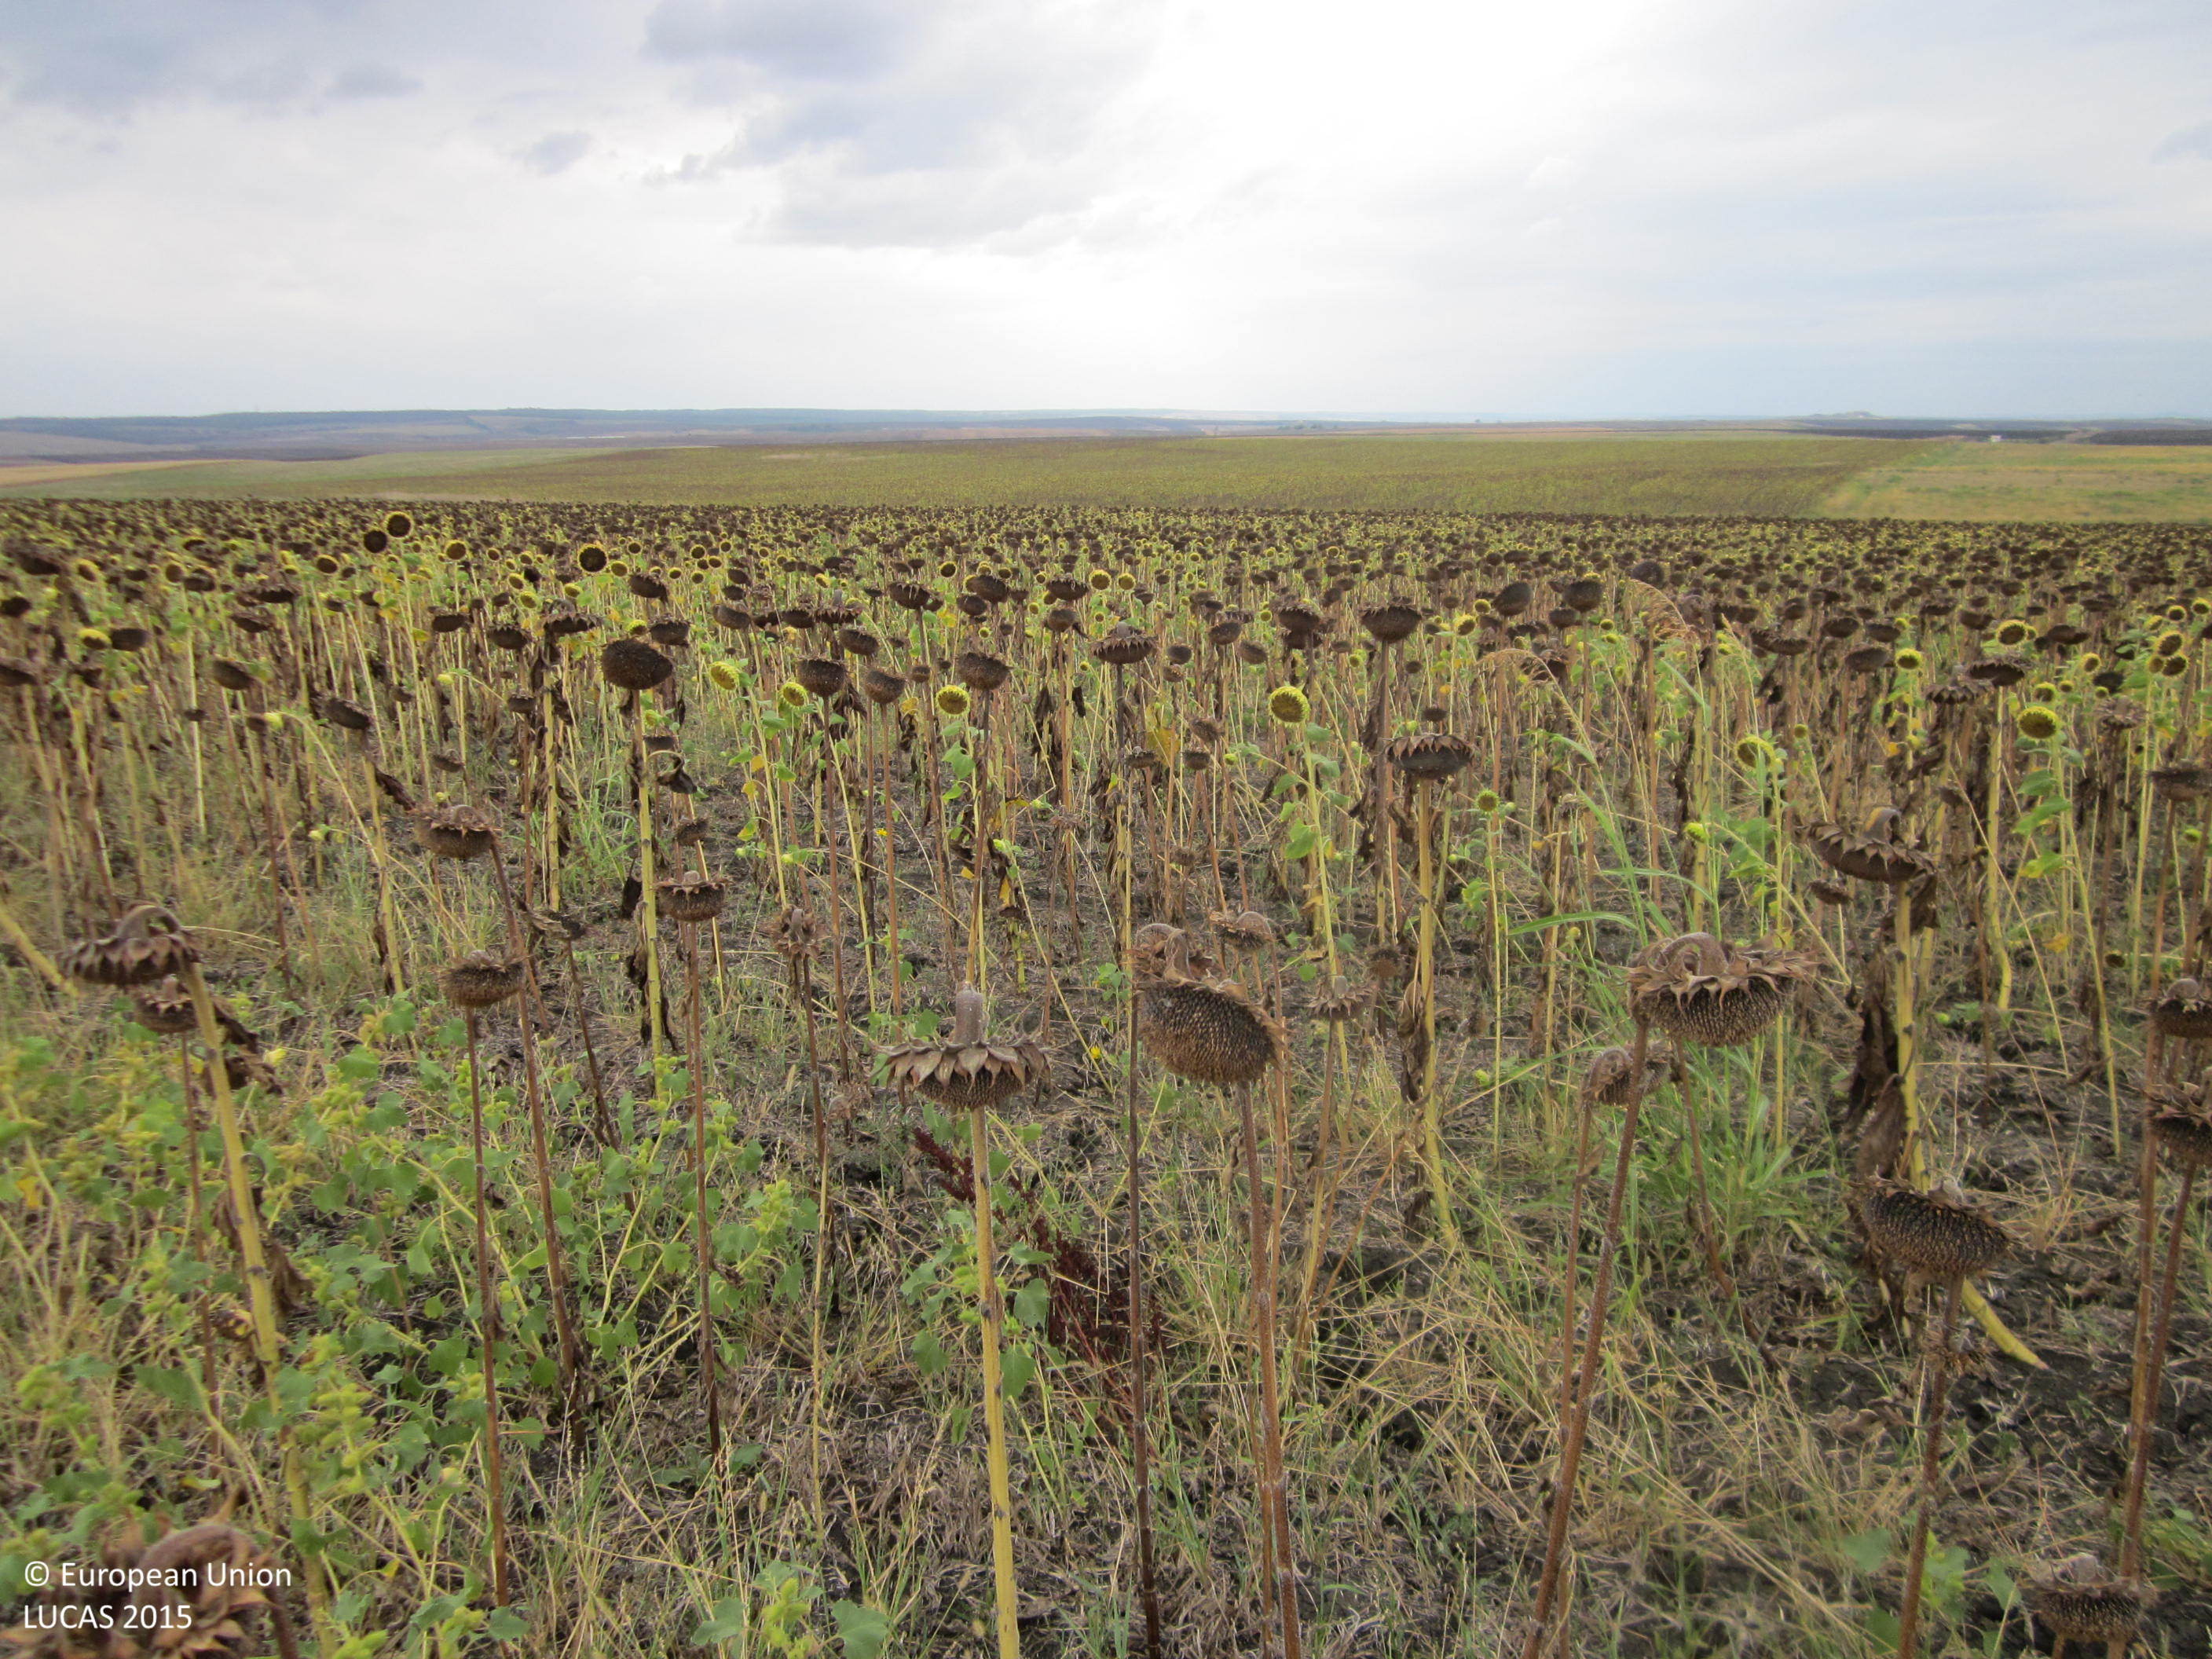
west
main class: Cropland
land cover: Sunflower
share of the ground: > 75 %
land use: Agriculture (excluding fallow land and kitchen gardens)
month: September
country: BG
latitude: 42.4734
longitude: 27.2239
